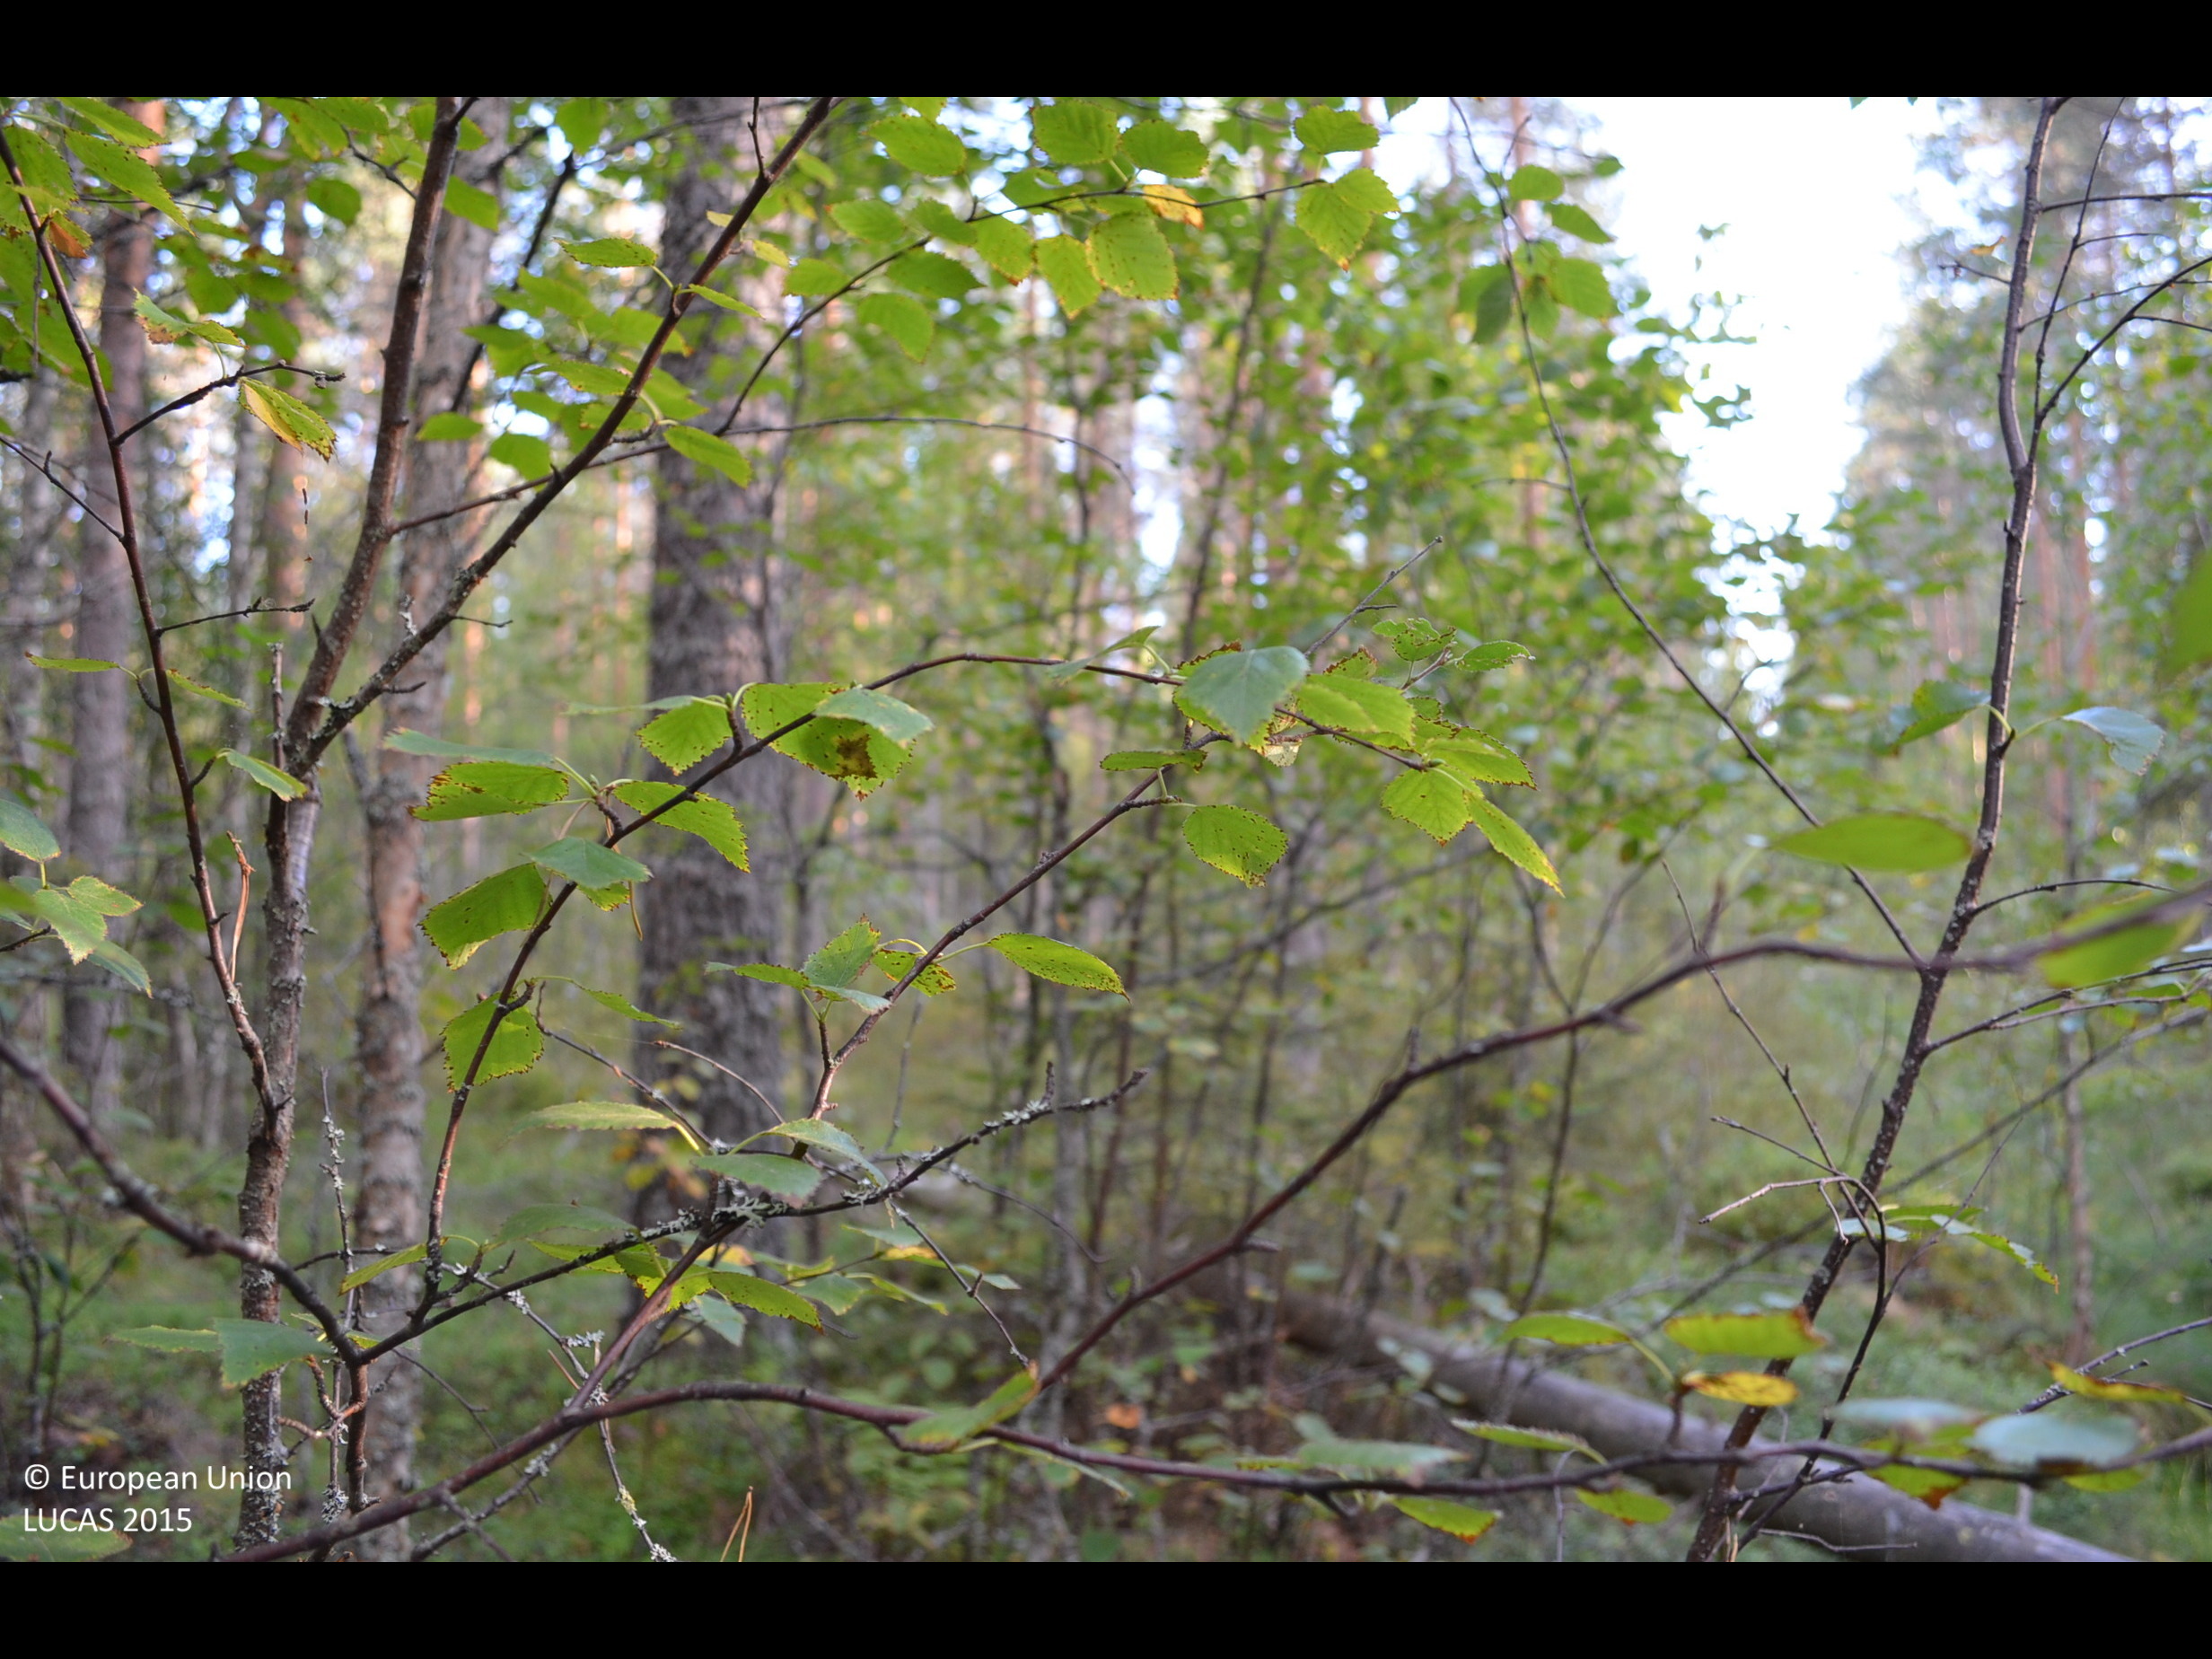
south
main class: Woodland
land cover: Pine dominated mixed woodland
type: boreal forest
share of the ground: > 75 %
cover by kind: coniferous forest trees 60 %, broadleaved forest trees 25 %, shrubs 10 %, herbaceous plants 5 %
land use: Forestry
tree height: > 5 m
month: August
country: FI
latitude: 62.4086
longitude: 24.4300
